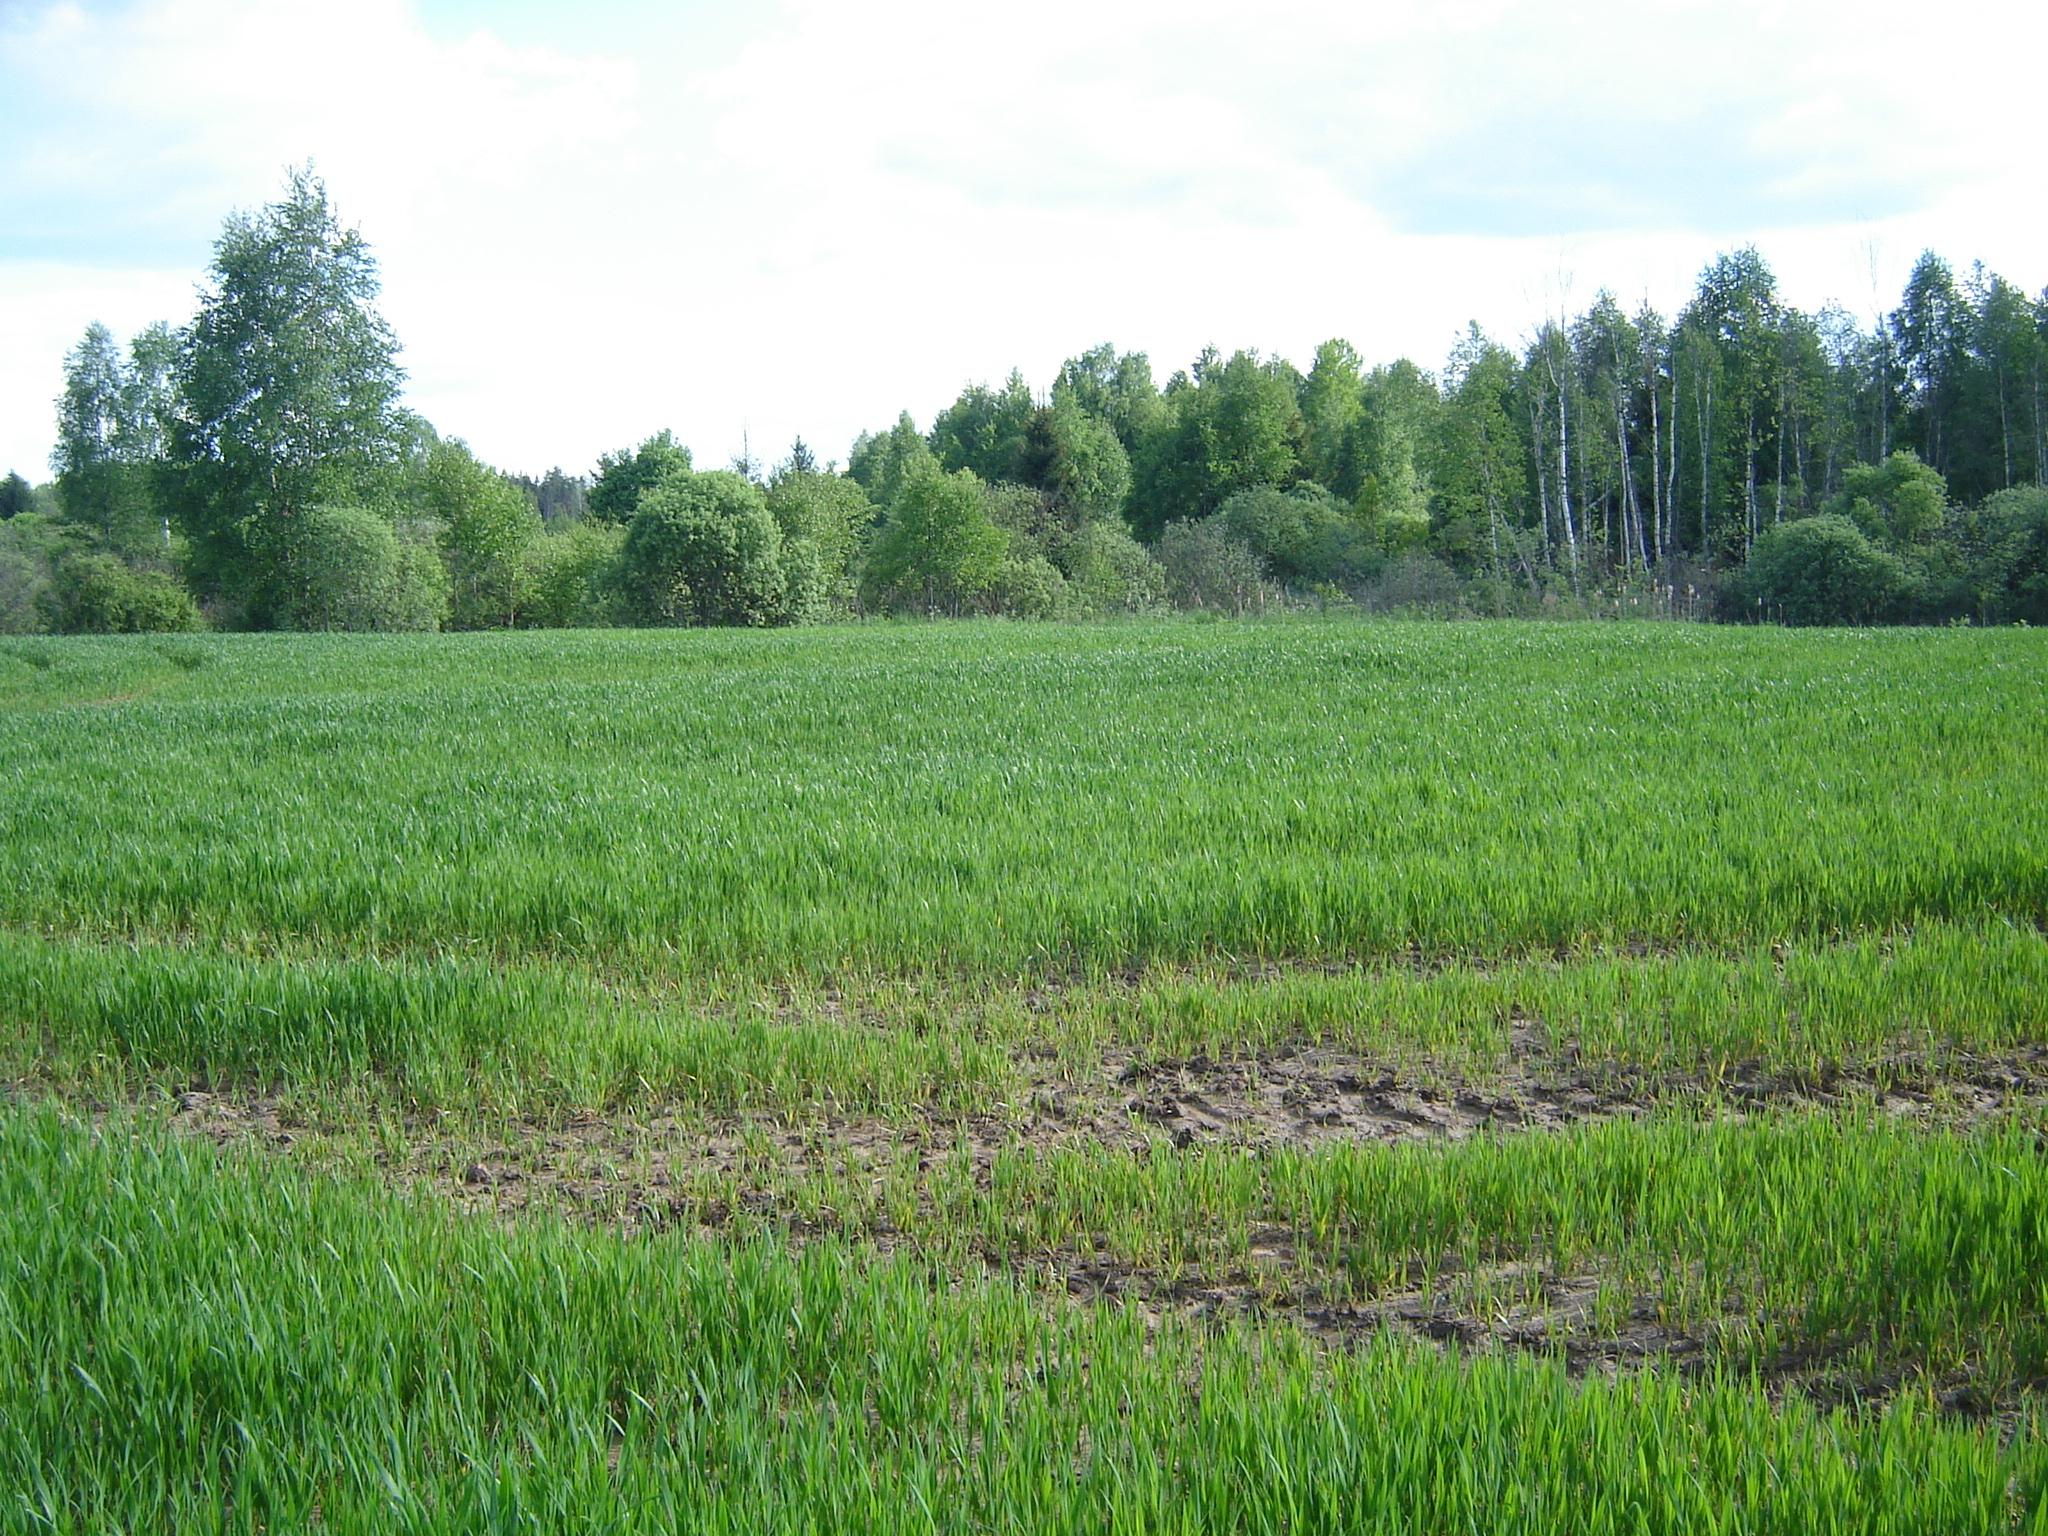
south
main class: Cropland
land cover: Barley
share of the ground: > 75 %
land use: Agriculture (excluding fallow land and kitchen gardens)
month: May
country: LT
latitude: 55.7295
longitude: 25.2280
